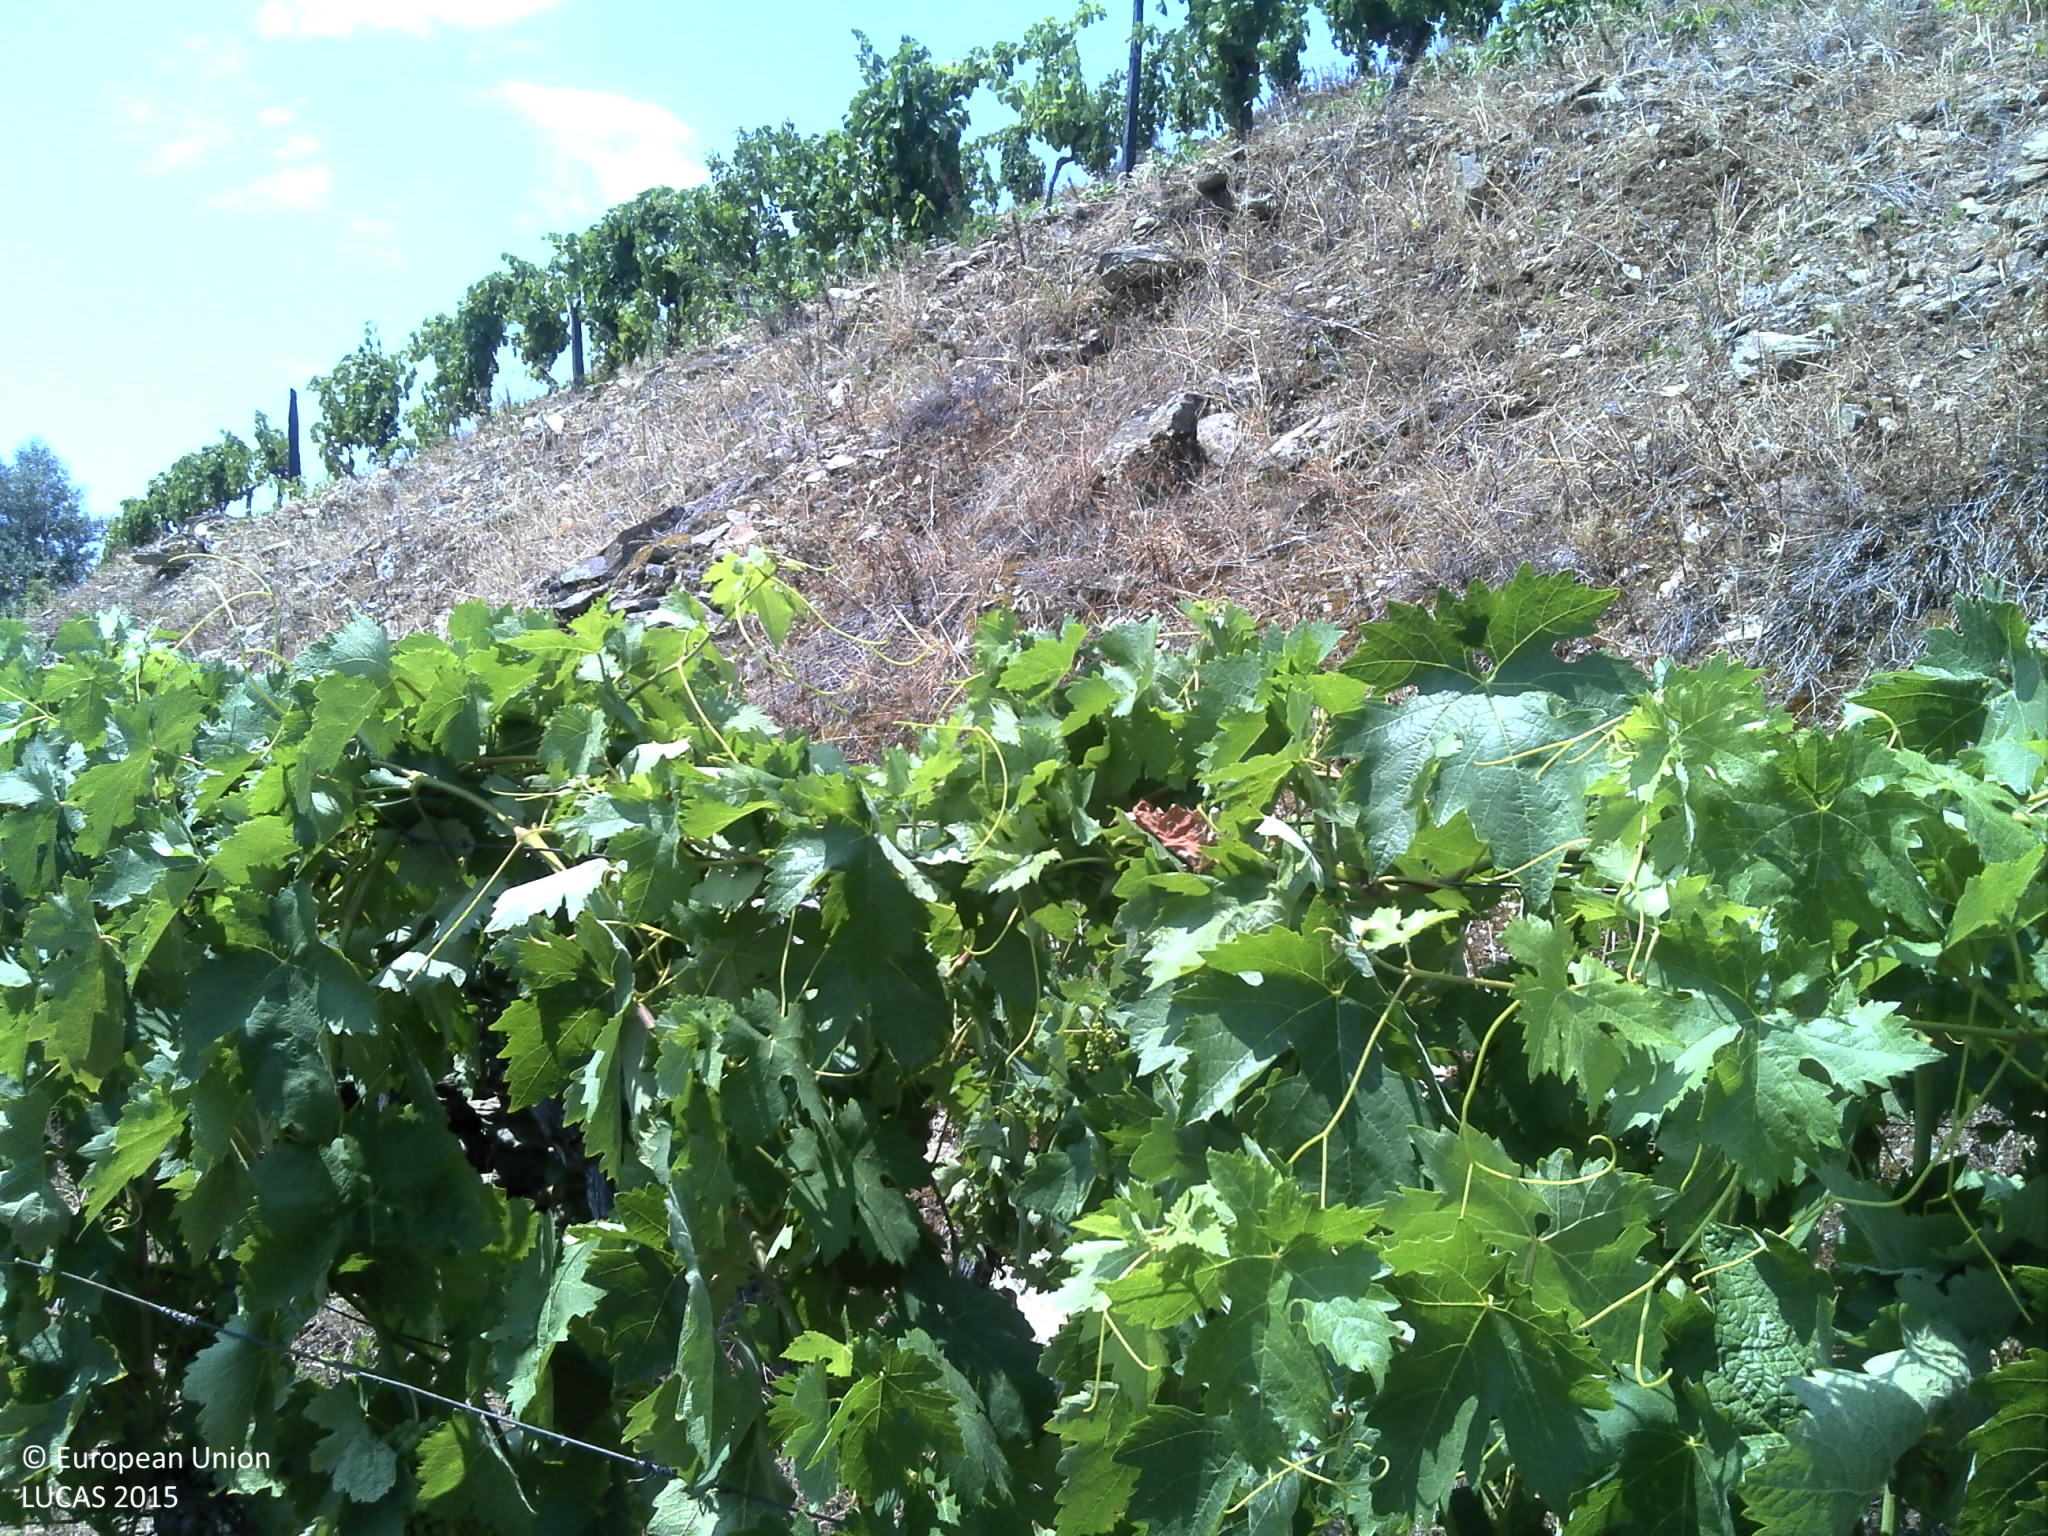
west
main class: Cropland
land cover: Vineyards
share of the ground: 10 - 25 %
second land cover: Spontaneously vegetated surfaces
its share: 10 - 25 %
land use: Agriculture (excluding fallow land and kitchen gardens)
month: June
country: PT
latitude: 41.2171
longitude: -7.4525
